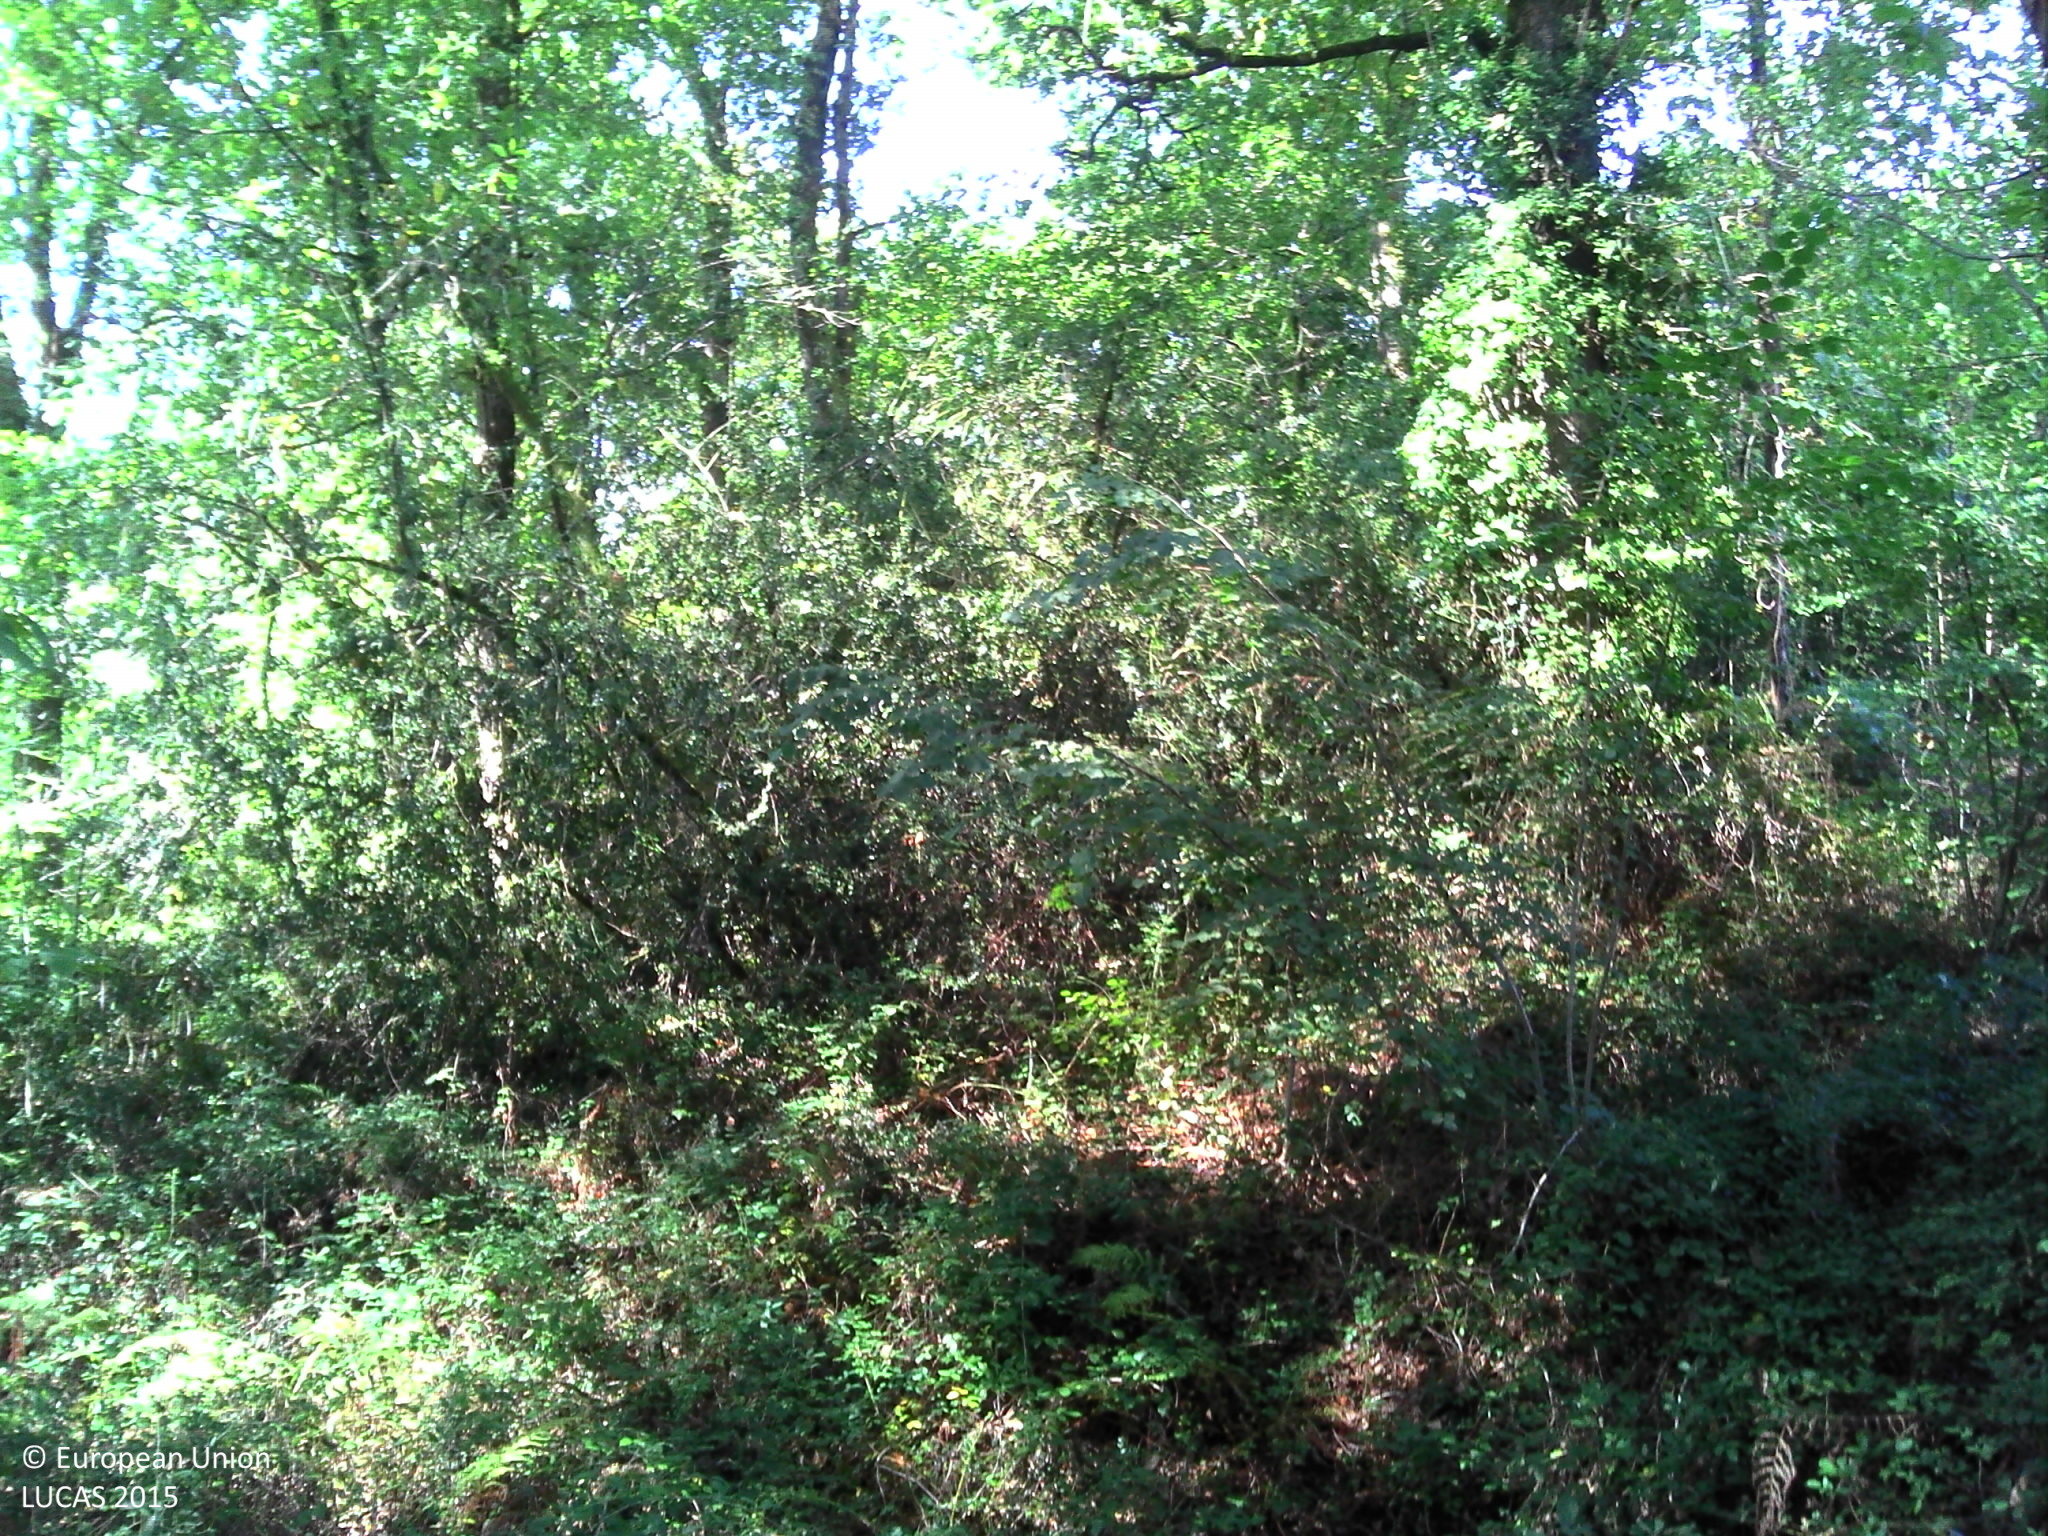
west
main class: Woodland
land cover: Broadleaved woodland
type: acidophilous oak and oak-birch forest
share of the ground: > 75 %
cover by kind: broadleaved forest trees 75 %, shrubs 15 %, herbaceous plants 5 %, lichens and mosses 5 %
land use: Forestry
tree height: > 5 m
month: September
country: FR
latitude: 43.2871
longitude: -0.6945
